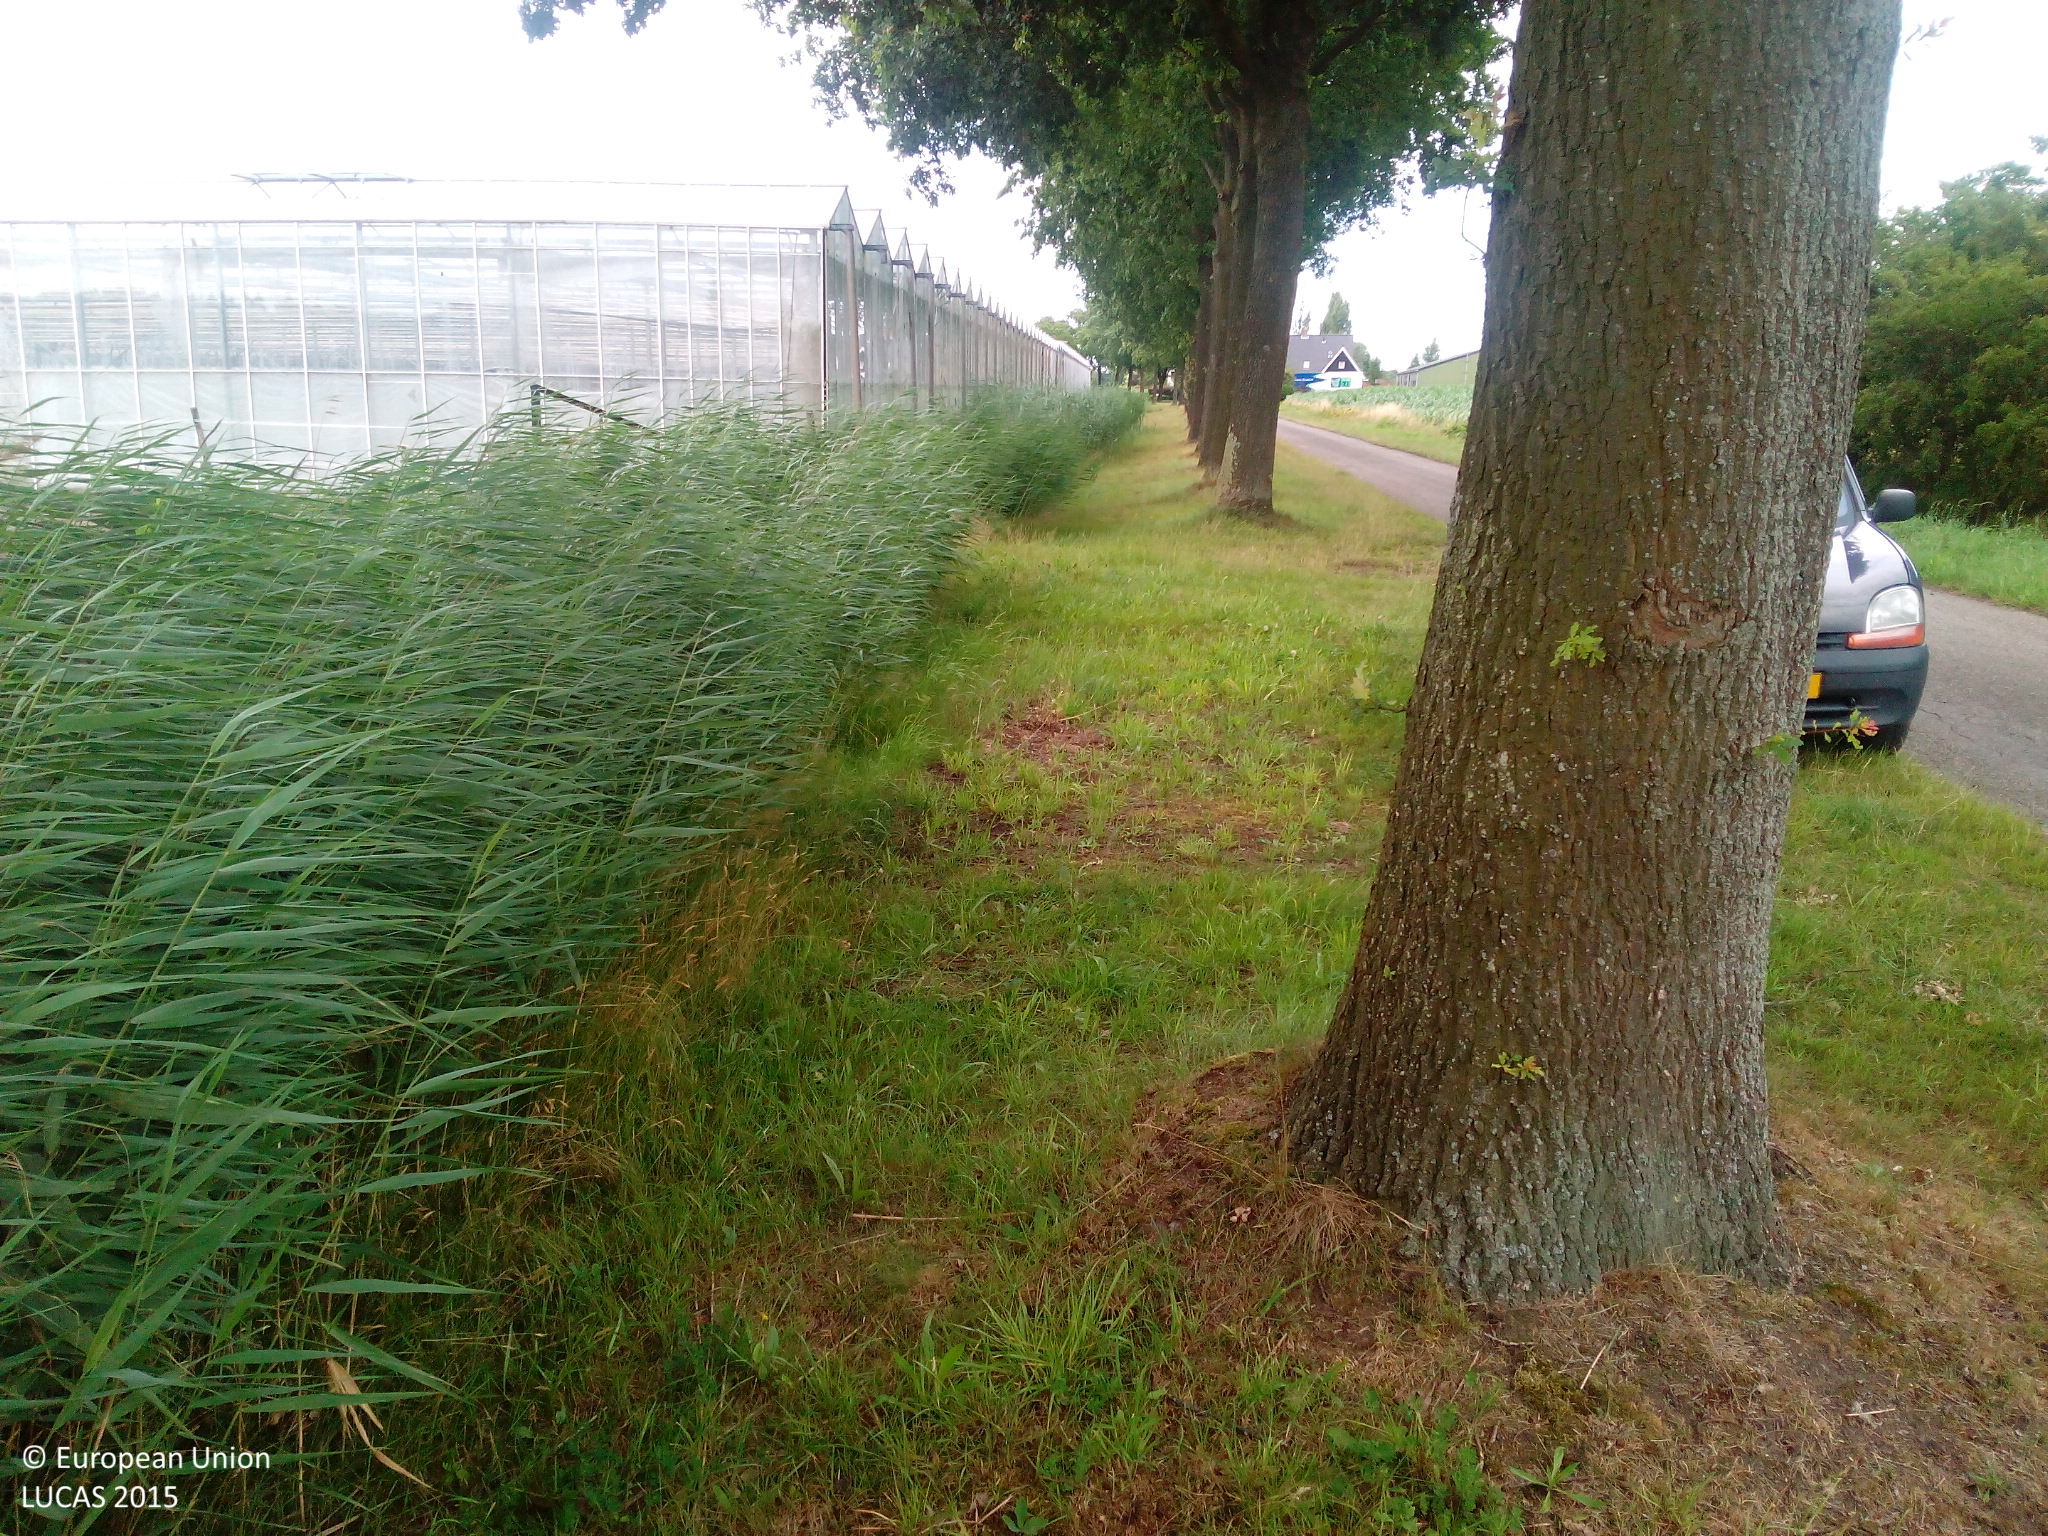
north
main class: Grassland
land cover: Grassland without tree/shrub cover
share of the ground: > 75 %
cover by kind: herbaceous plants 100 %
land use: Amenities, museums, leisure
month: July
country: NL
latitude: 51.5925
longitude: 4.6988
